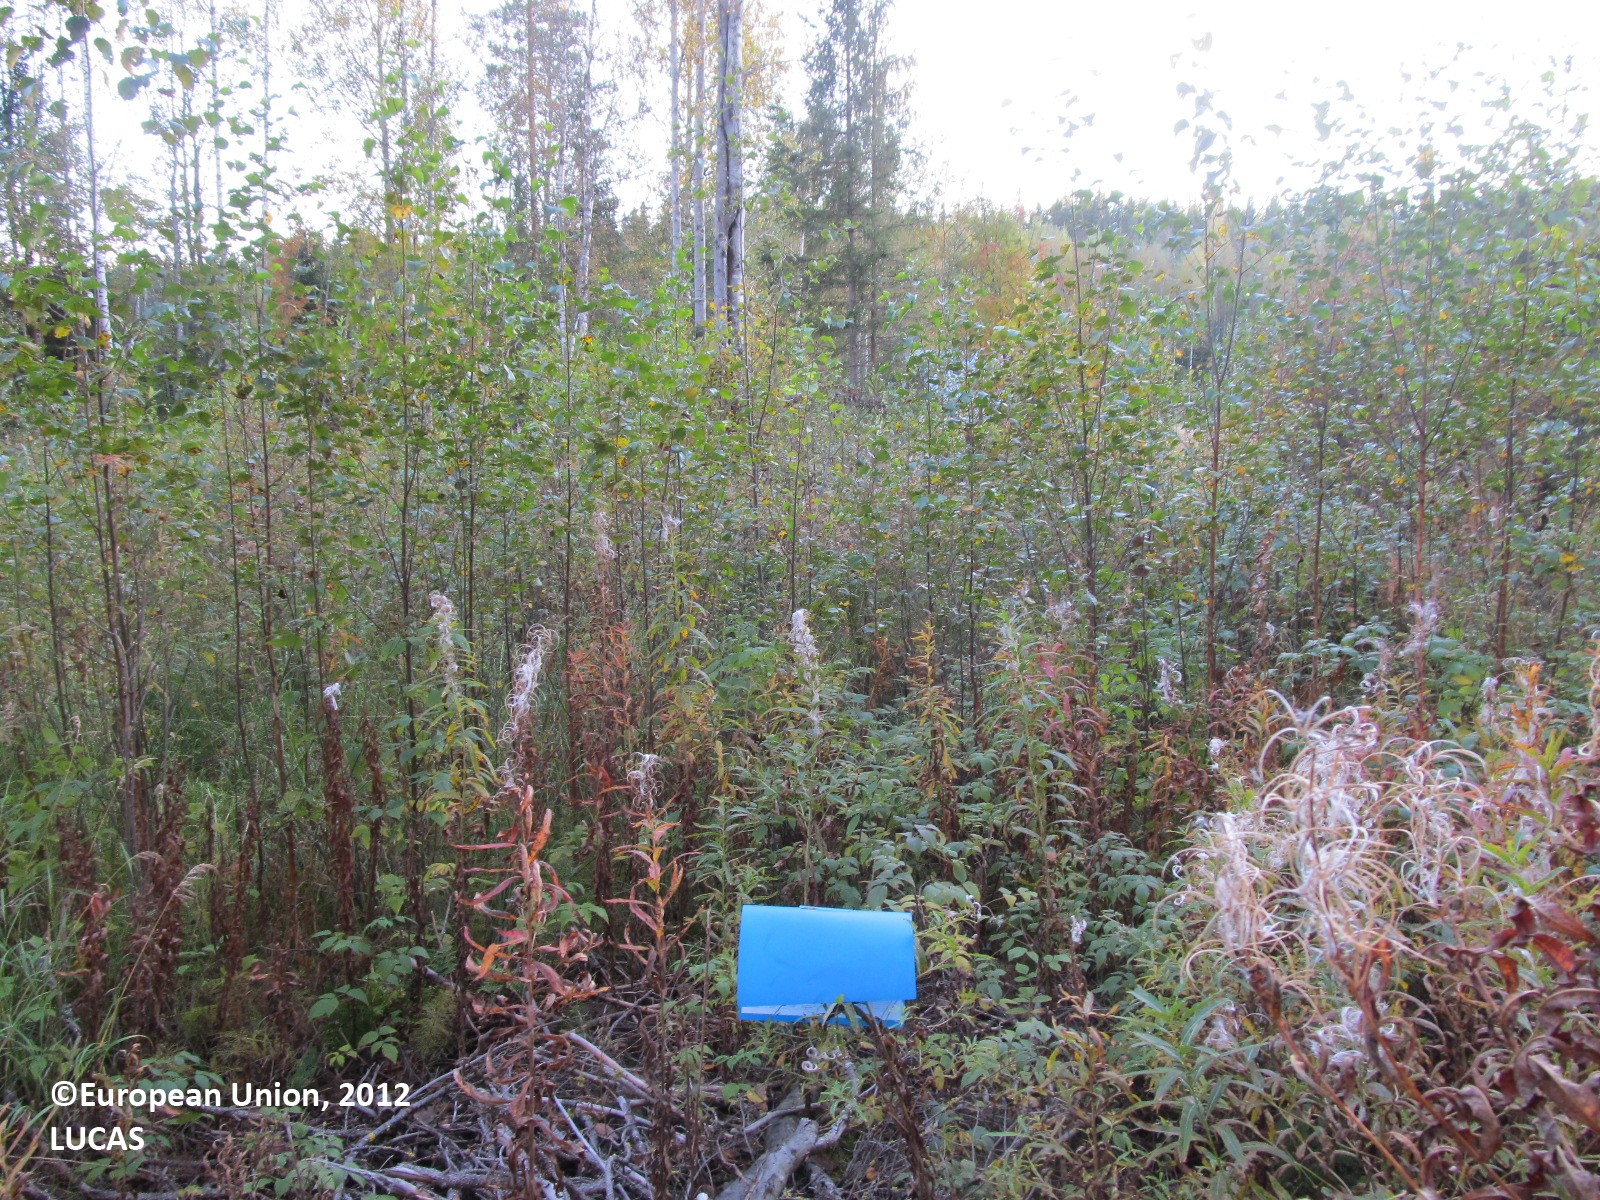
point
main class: Woodland
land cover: Broadleaved woodland
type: boreal forest
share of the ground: 25 - 50 %
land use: Forestry
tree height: > 5 m
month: September
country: FI
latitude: 62.3991
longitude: 28.6455
